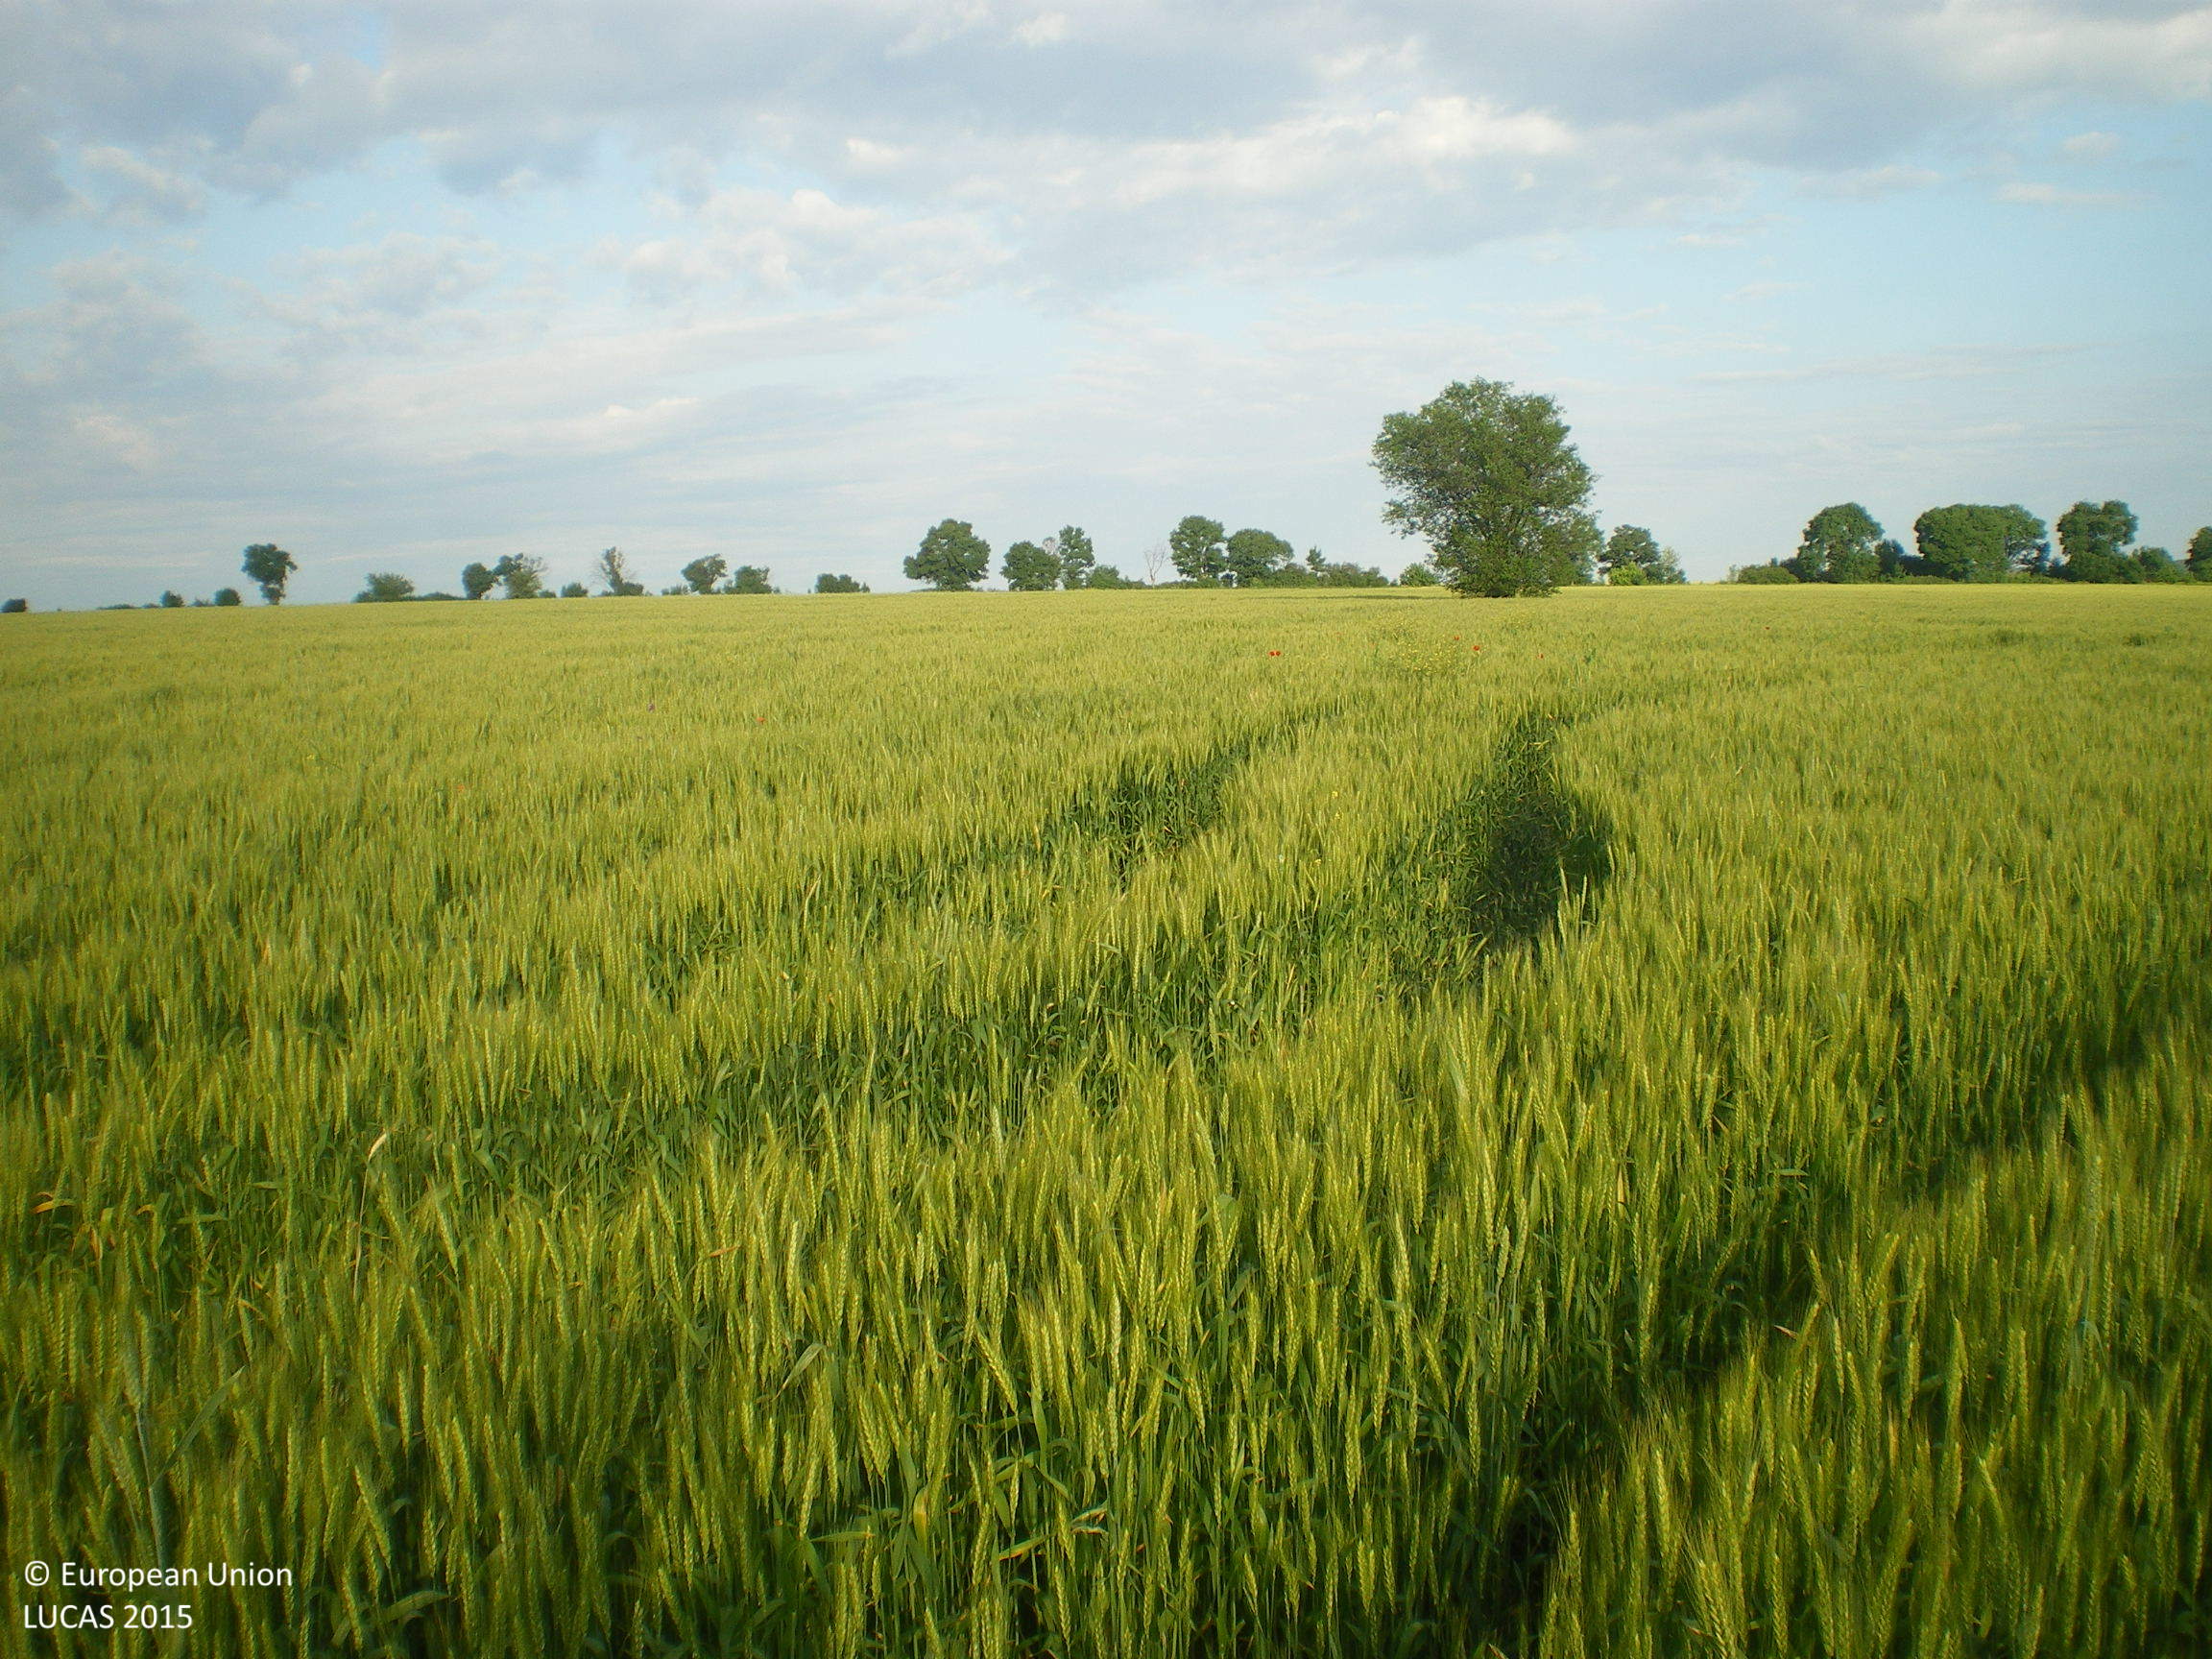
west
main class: Cropland
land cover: Common wheat
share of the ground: > 75 %
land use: Agriculture (excluding fallow land and kitchen gardens)
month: May
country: BG
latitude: 42.1971
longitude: 25.4330
